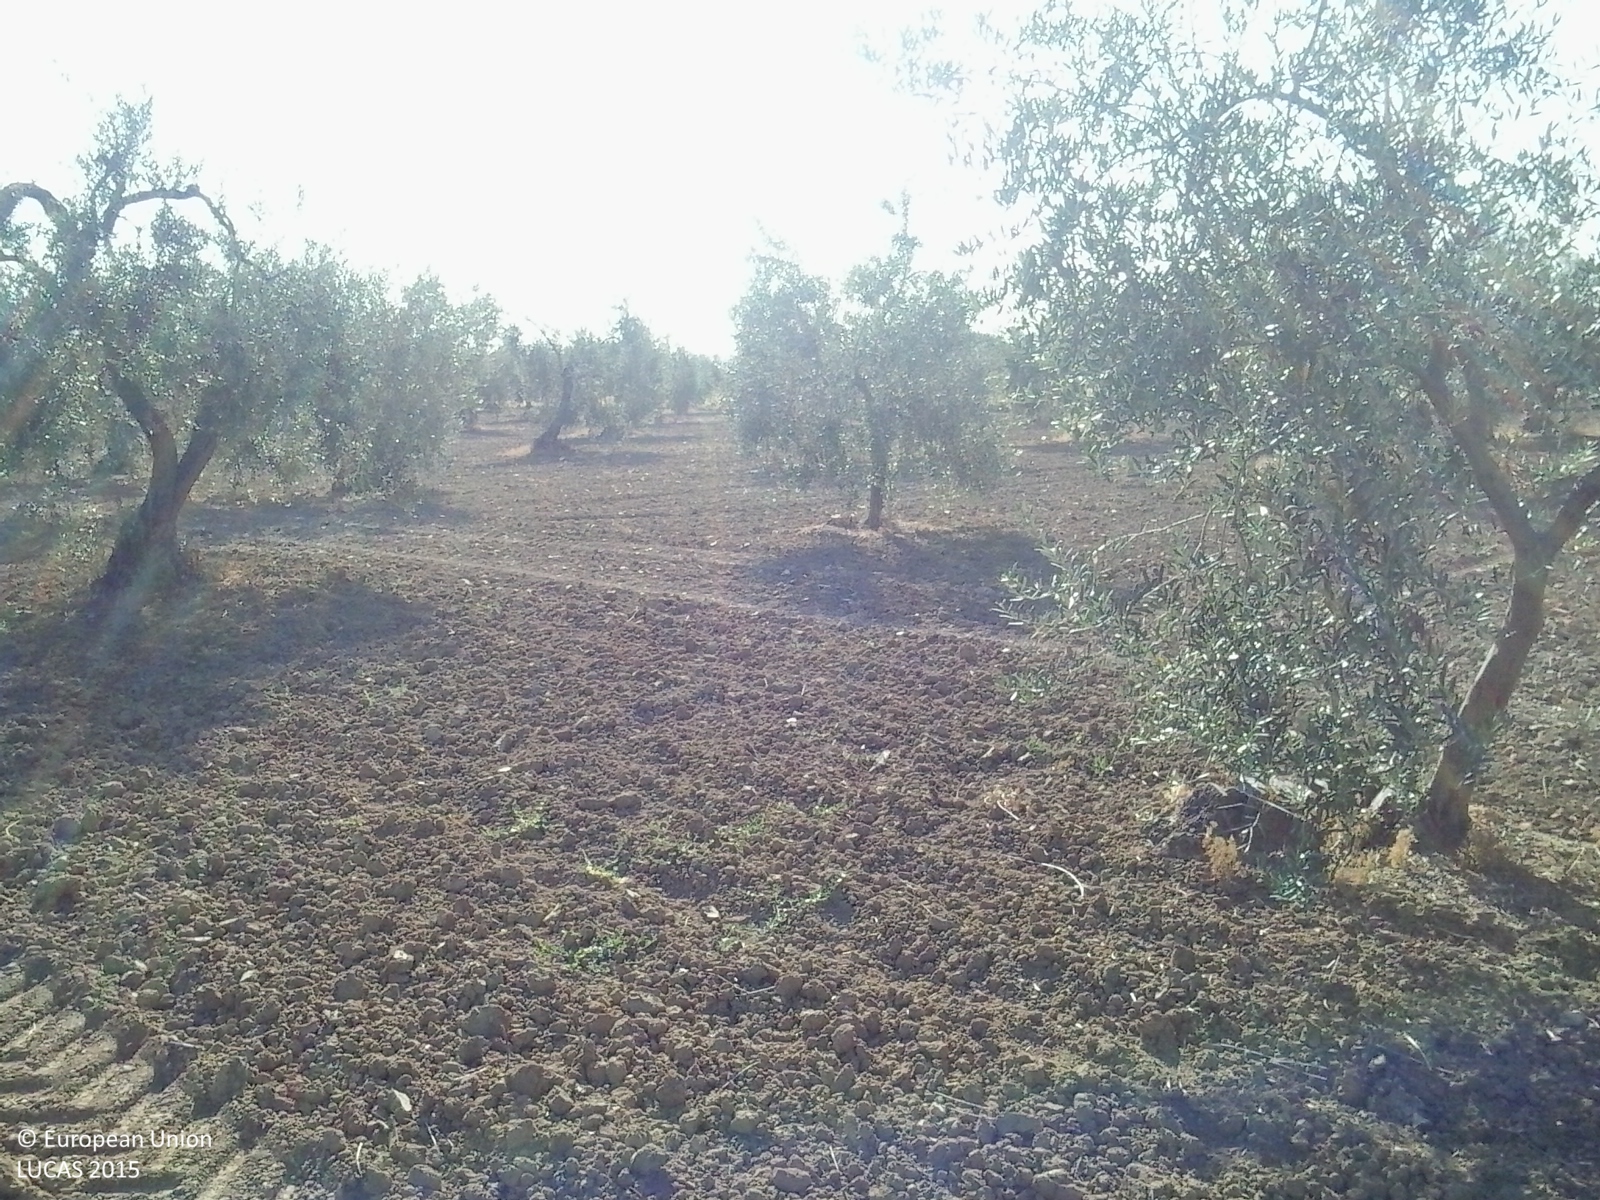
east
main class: Cropland
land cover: Olive groves
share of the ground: 25 - 50 %
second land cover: Other bare soil
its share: > 75 %
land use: Agriculture (excluding fallow land and kitchen gardens)
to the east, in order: Olive groves; Other bare soil; Grass margins; Durum wheat; Grass margins; Olive groves; Tracks; Grassland without tree/shrub cover; Ditches and canals; Tracks; Ditches and canals; Olive groves
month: June
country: ES
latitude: 37.4404
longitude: -6.1791
